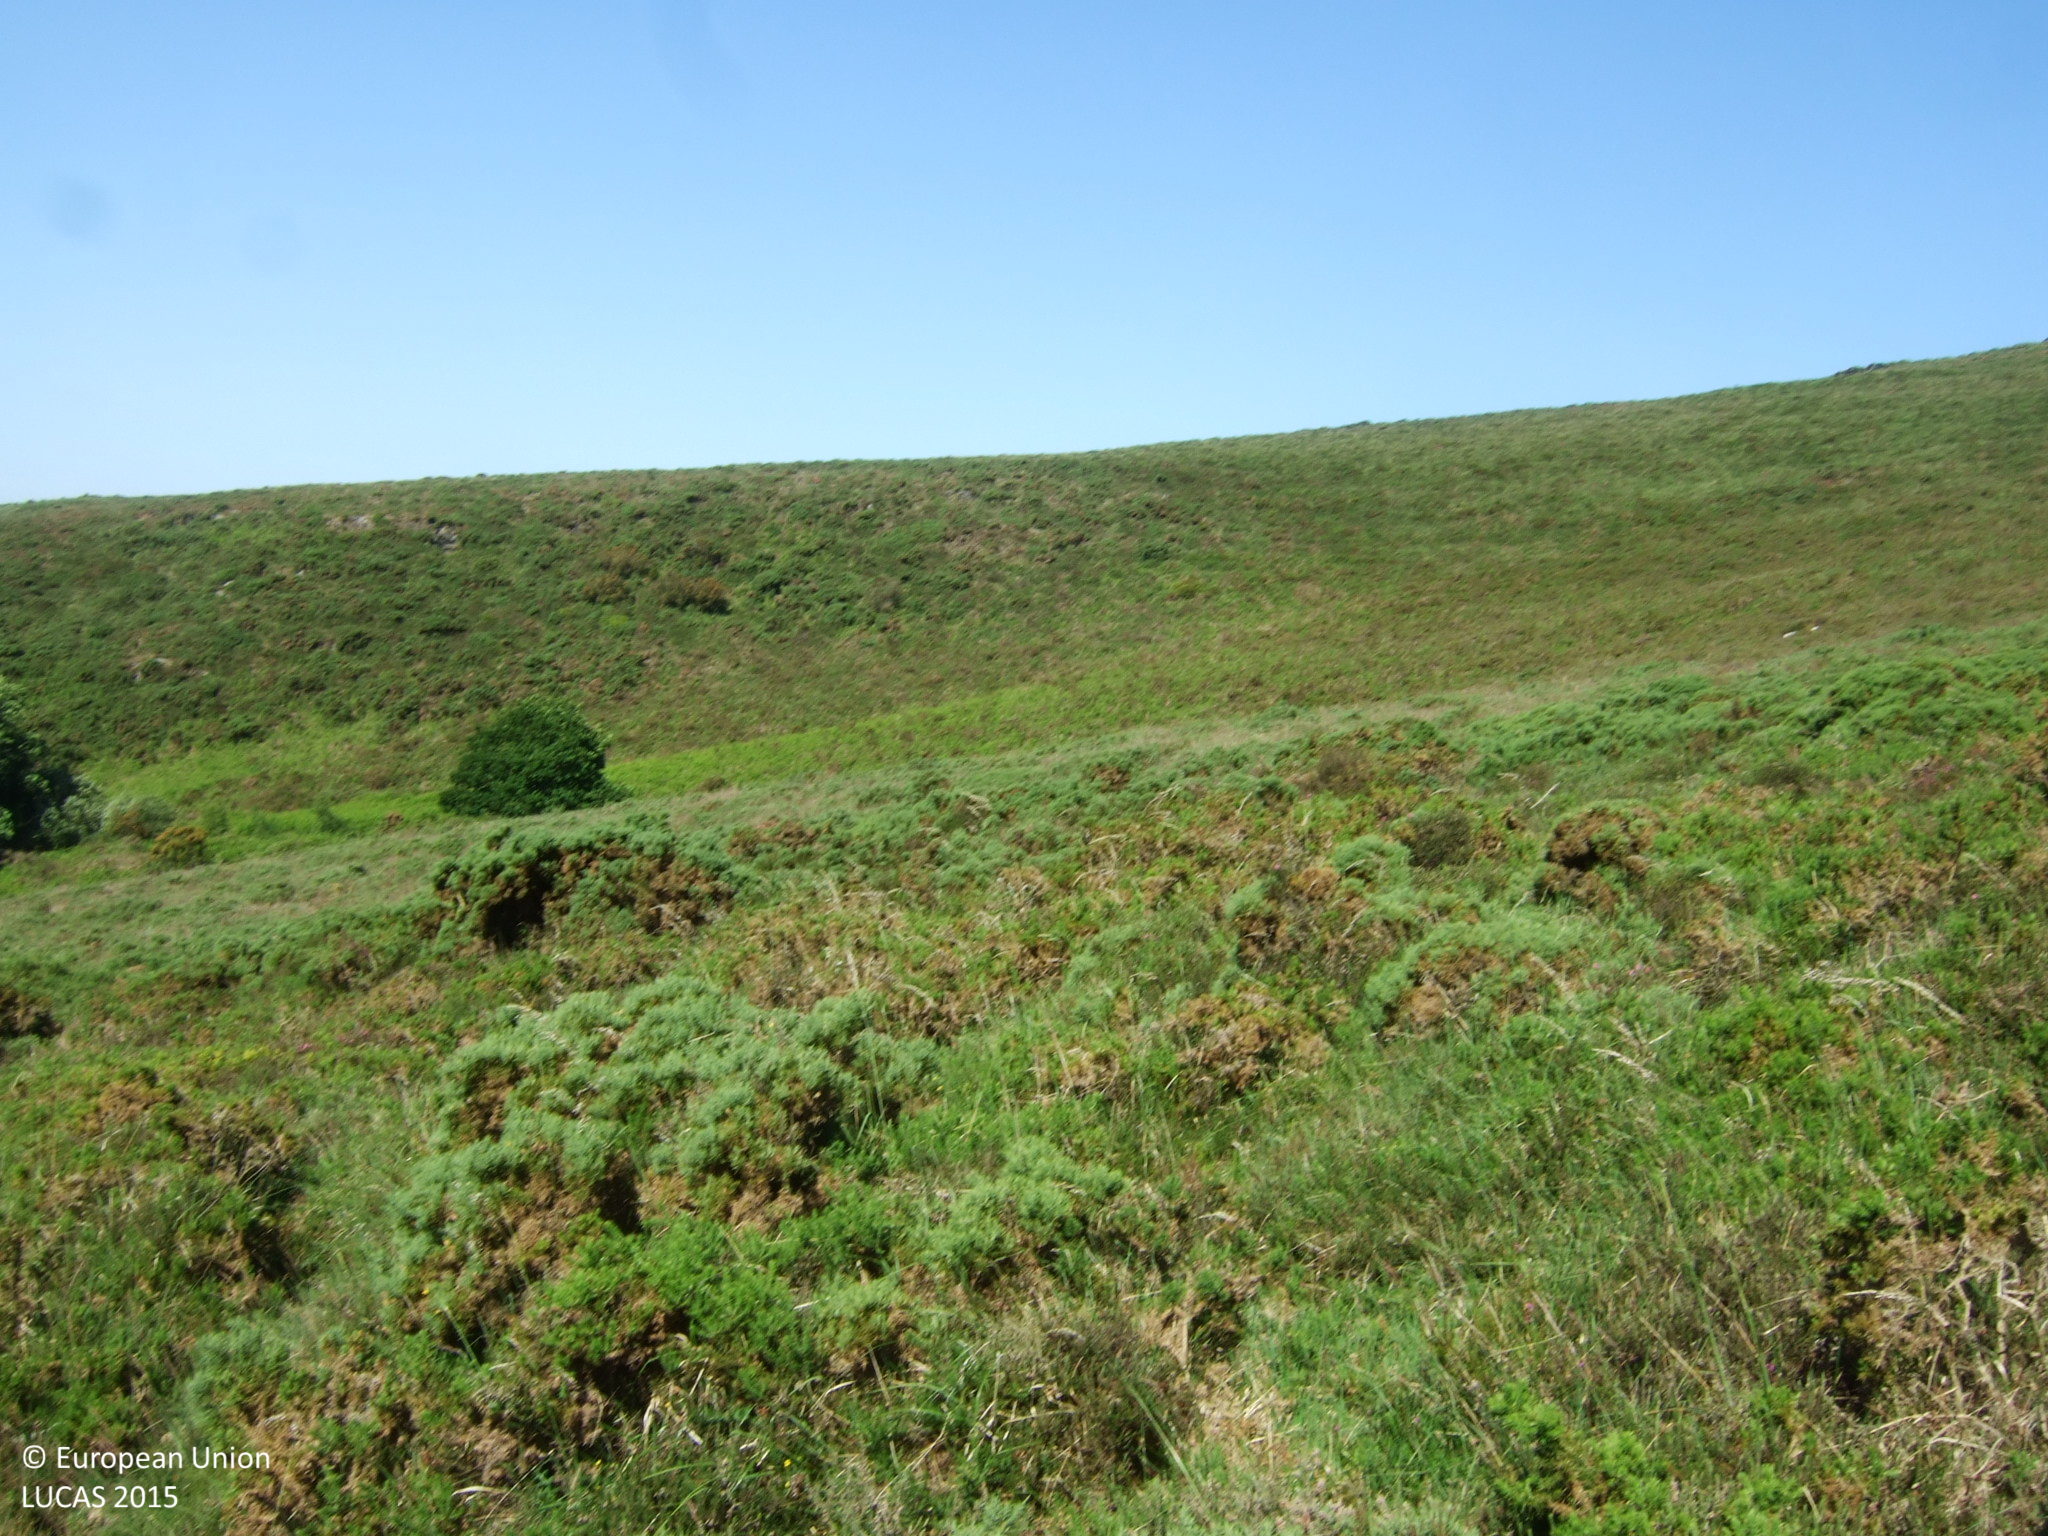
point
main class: Shrubland
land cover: Shrubland without tree cover
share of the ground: > 75 %
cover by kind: shrubs 90 %, herbaceous plants 10 %
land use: Semi-natural and natural areas not in use
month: June
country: ES
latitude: 43.4901
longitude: -7.7337
